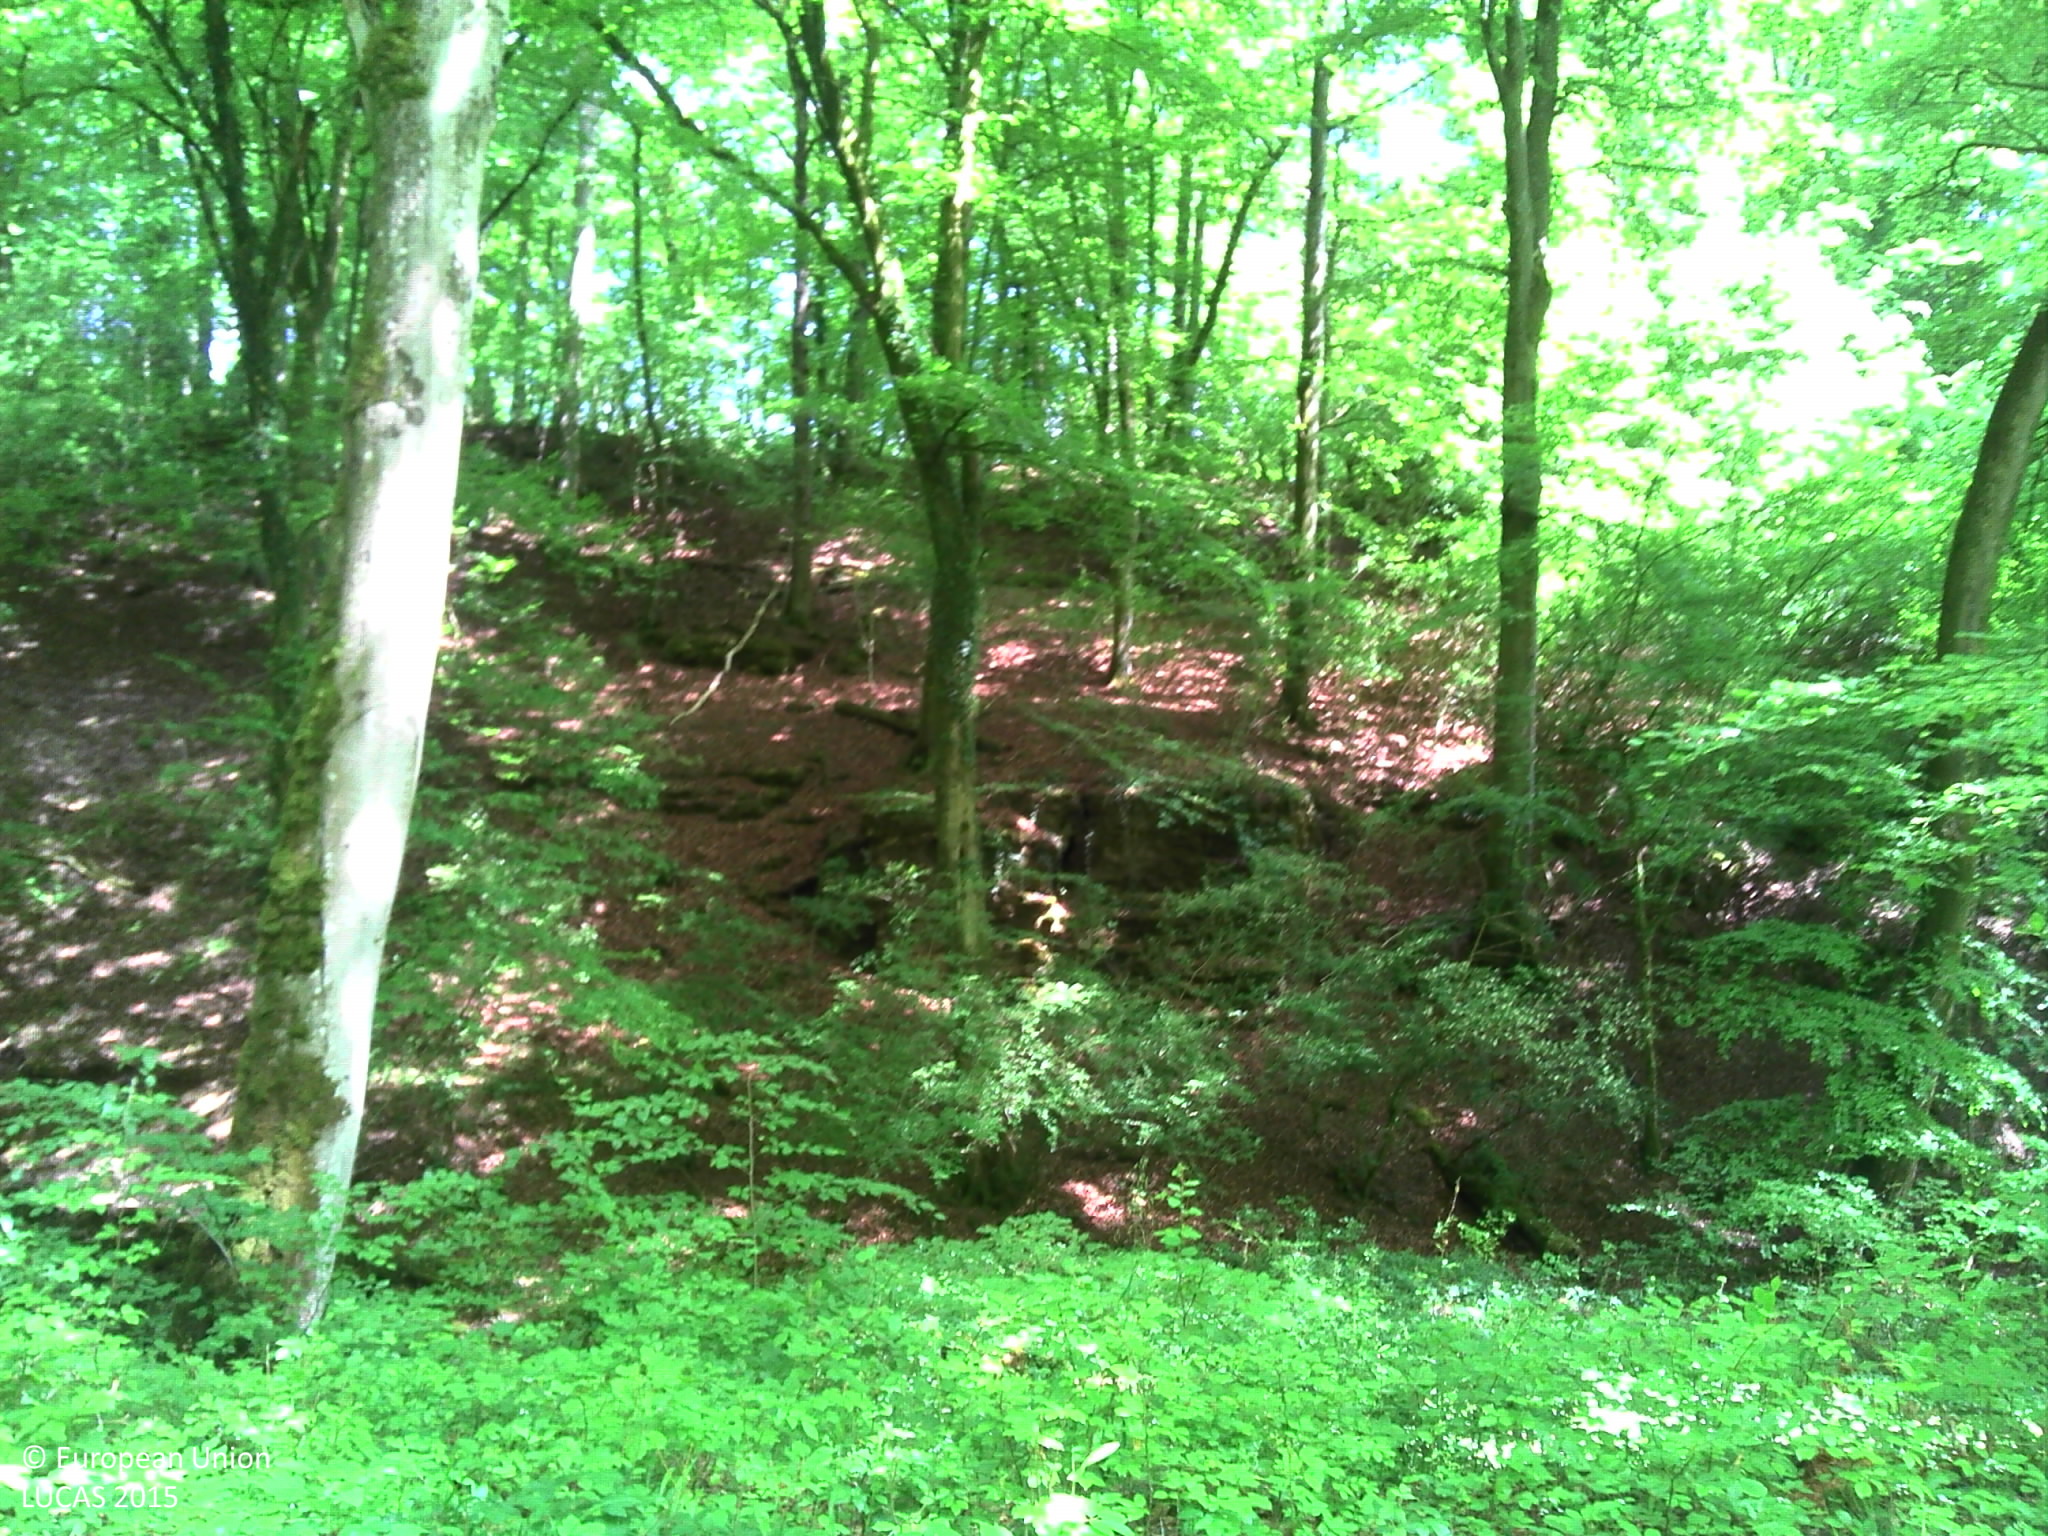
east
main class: Woodland
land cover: Broadleaved woodland
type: acidophilous oak and oak-birch forest
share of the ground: > 75 %
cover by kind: broadleaved forest trees 95 %, herbaceous plants 5 %
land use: Forestry
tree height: > 5 m
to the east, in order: Broadleaved woodland; Rivers and streams; Broadleaved woodland; Shrubland with sparse tree cover; Spruce dominated mixed woodland; Tracks
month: May
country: LU
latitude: 49.7334
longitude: 6.4618
